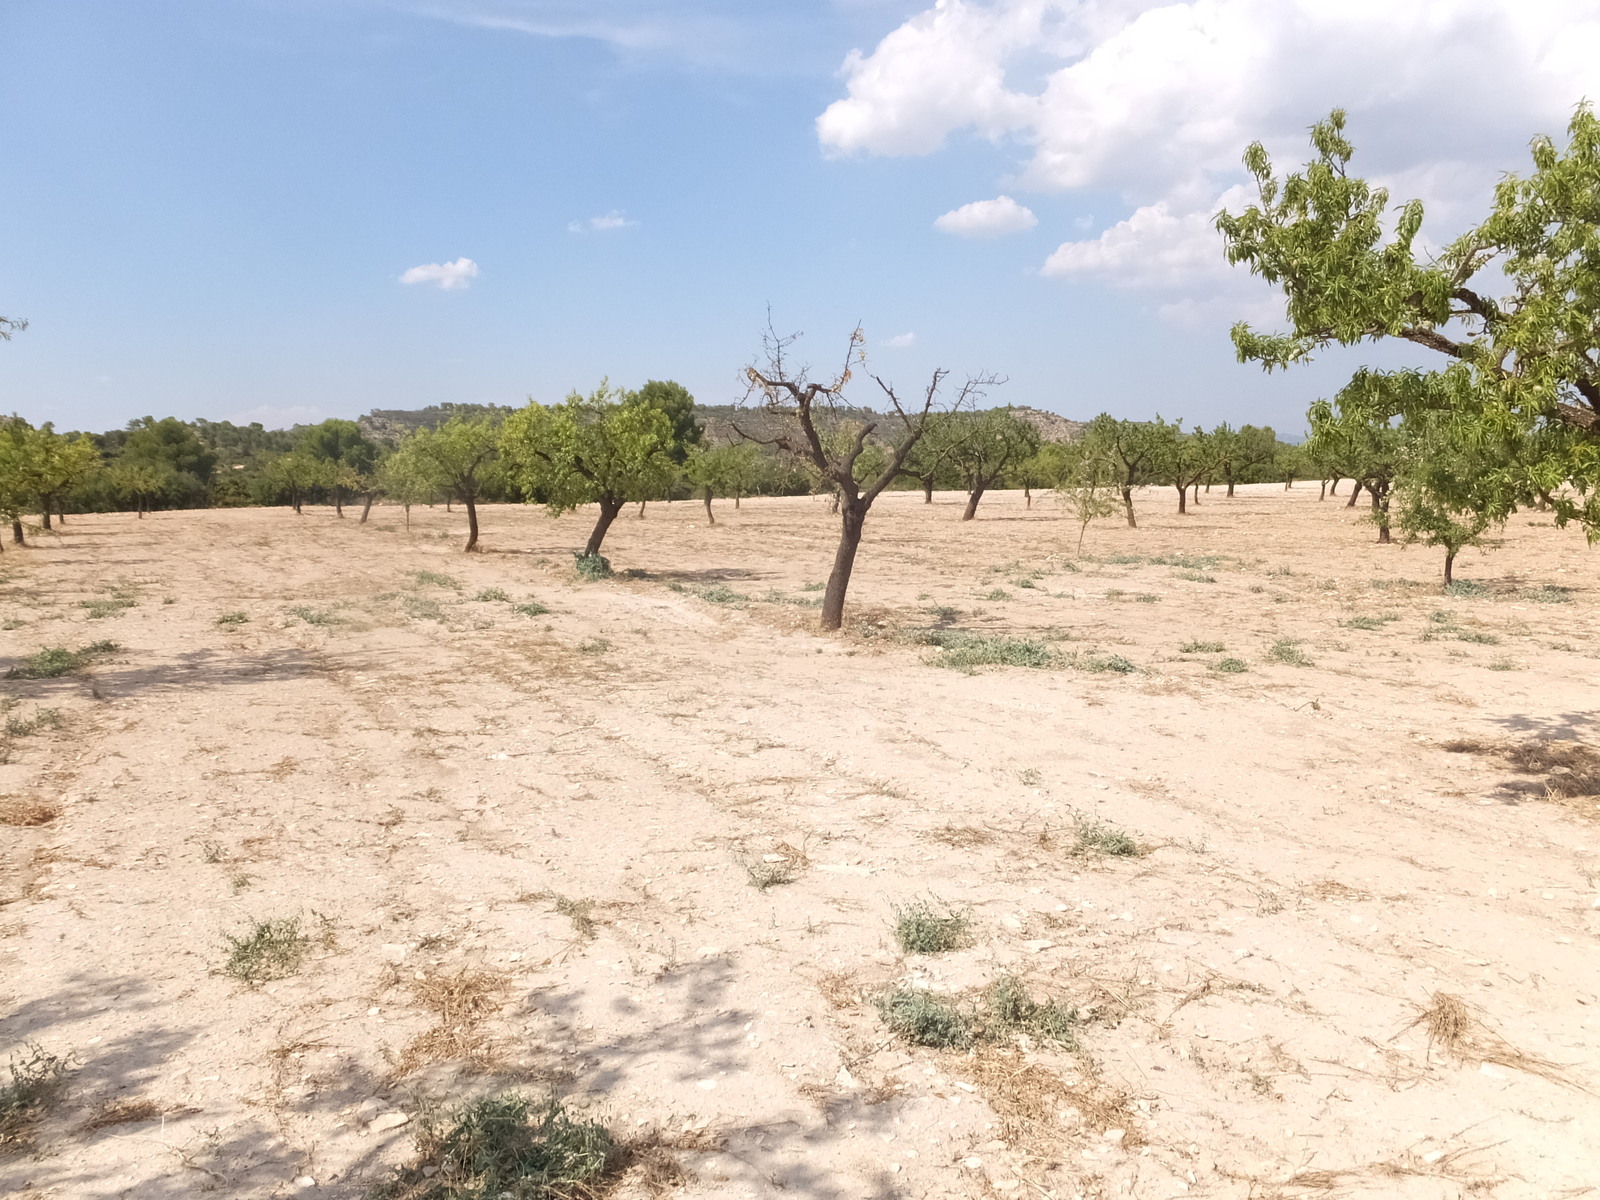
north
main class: Cropland
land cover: Nuts trees
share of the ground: > 75 %
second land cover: Other bare soil
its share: > 75 %
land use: Agriculture (excluding fallow land and kitchen gardens)
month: July
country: ES
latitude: 41.1955
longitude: 0.1997
